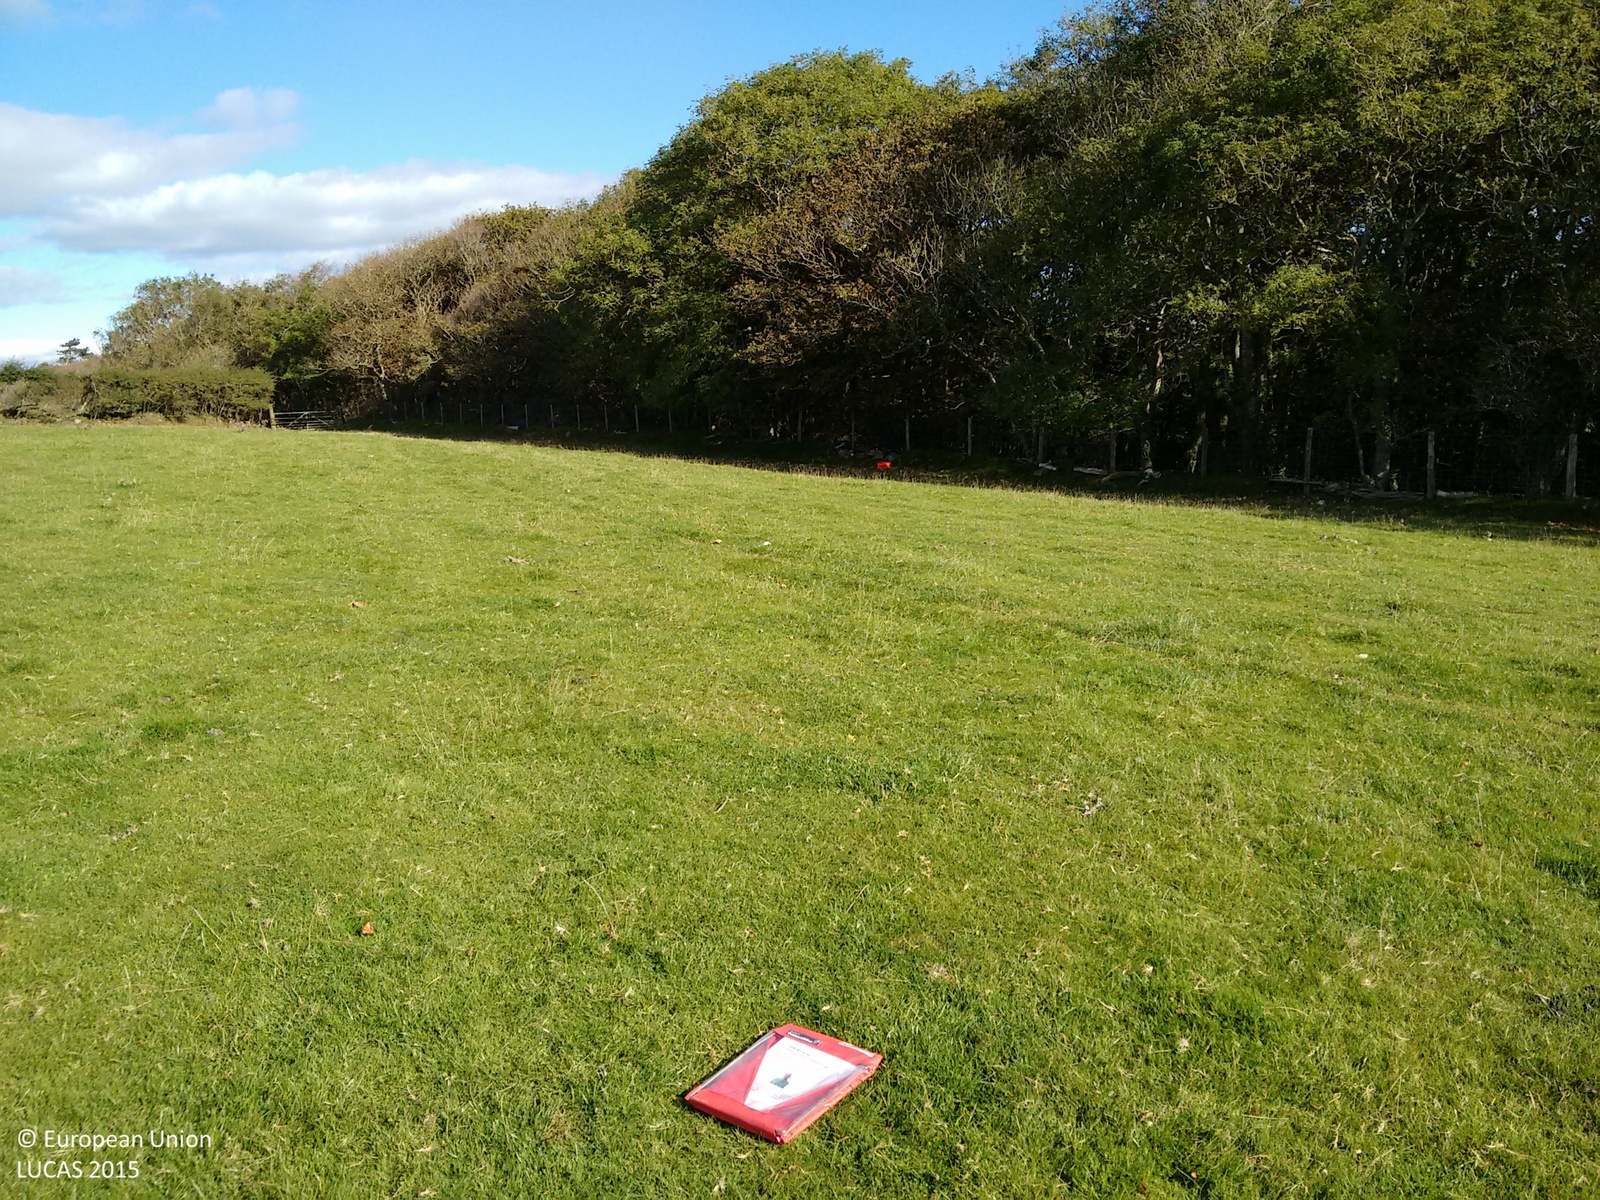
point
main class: Grassland
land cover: Grassland without tree/shrub cover
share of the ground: > 75 %
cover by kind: herbaceous plants 100 %
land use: Agriculture (excluding fallow land and kitchen gardens)
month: October
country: GB
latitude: 52.3324
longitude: -4.1115
